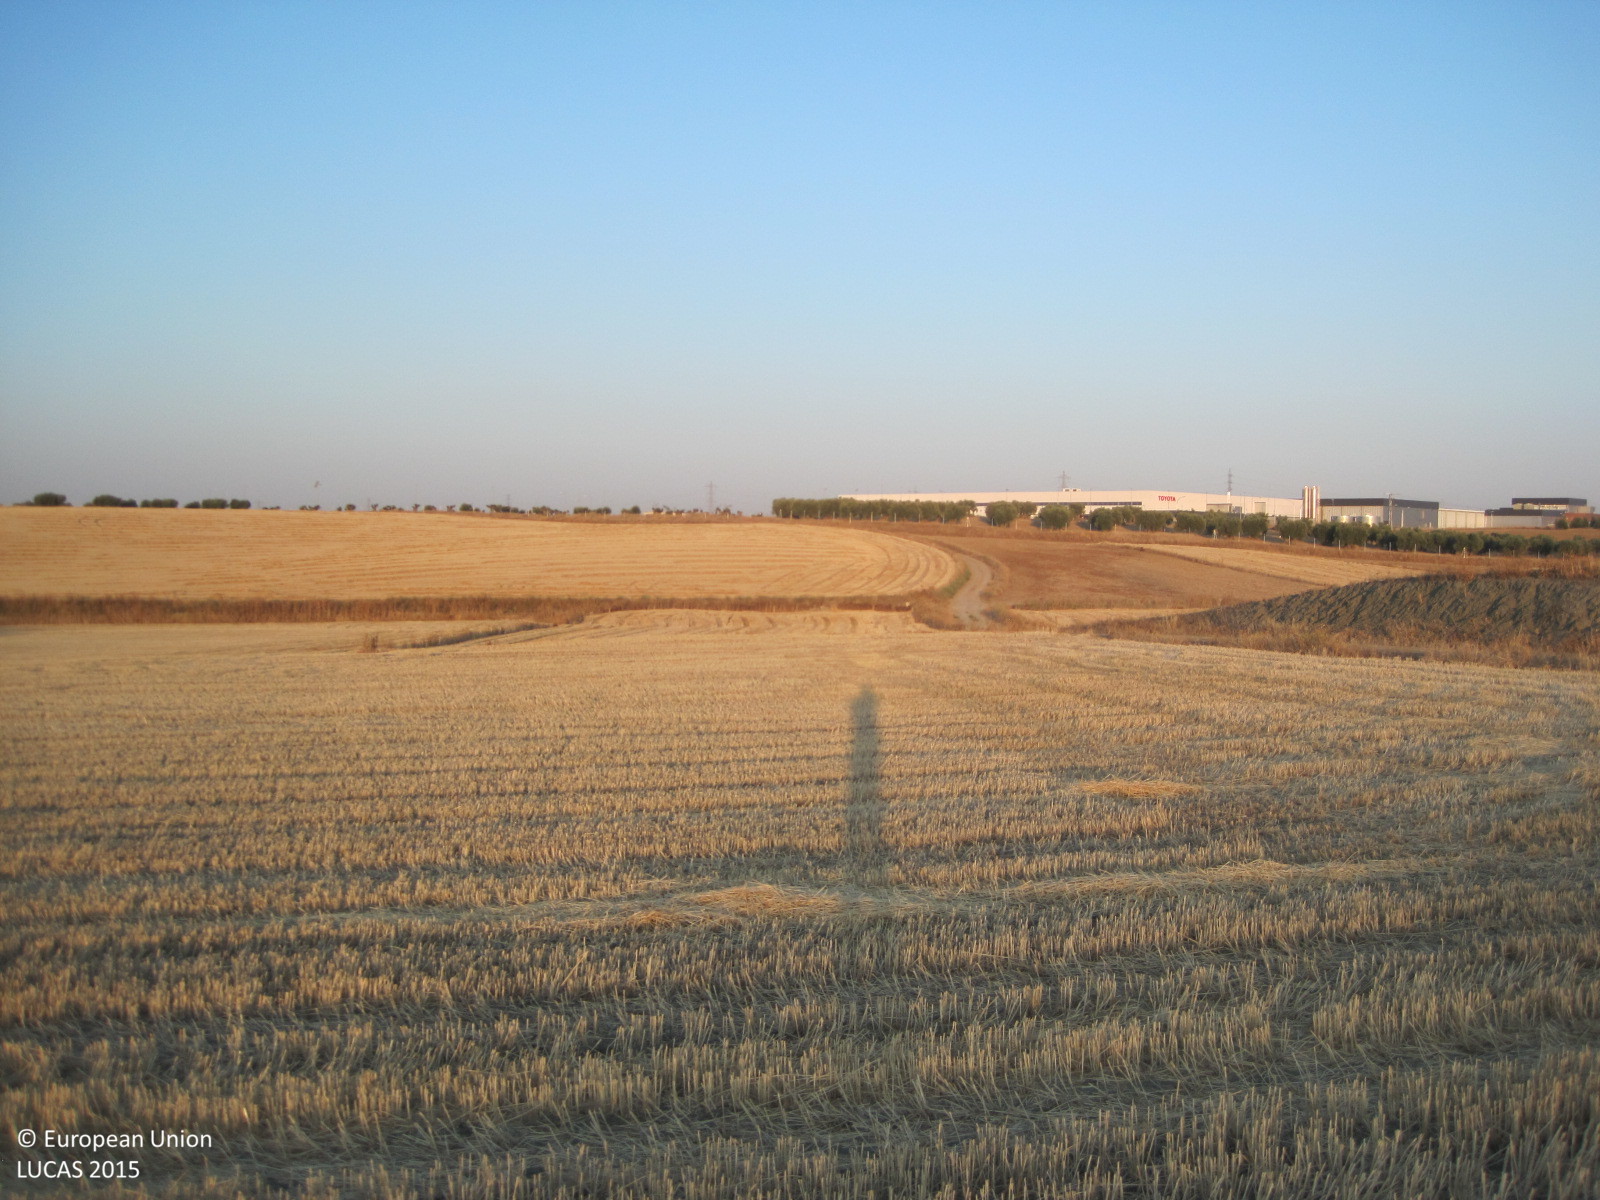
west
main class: Cropland
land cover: Barley
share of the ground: < 10 %
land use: Agriculture (excluding fallow land and kitchen gardens)
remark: Harvested field
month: July
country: ES
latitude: 40.1087
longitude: -3.8200
